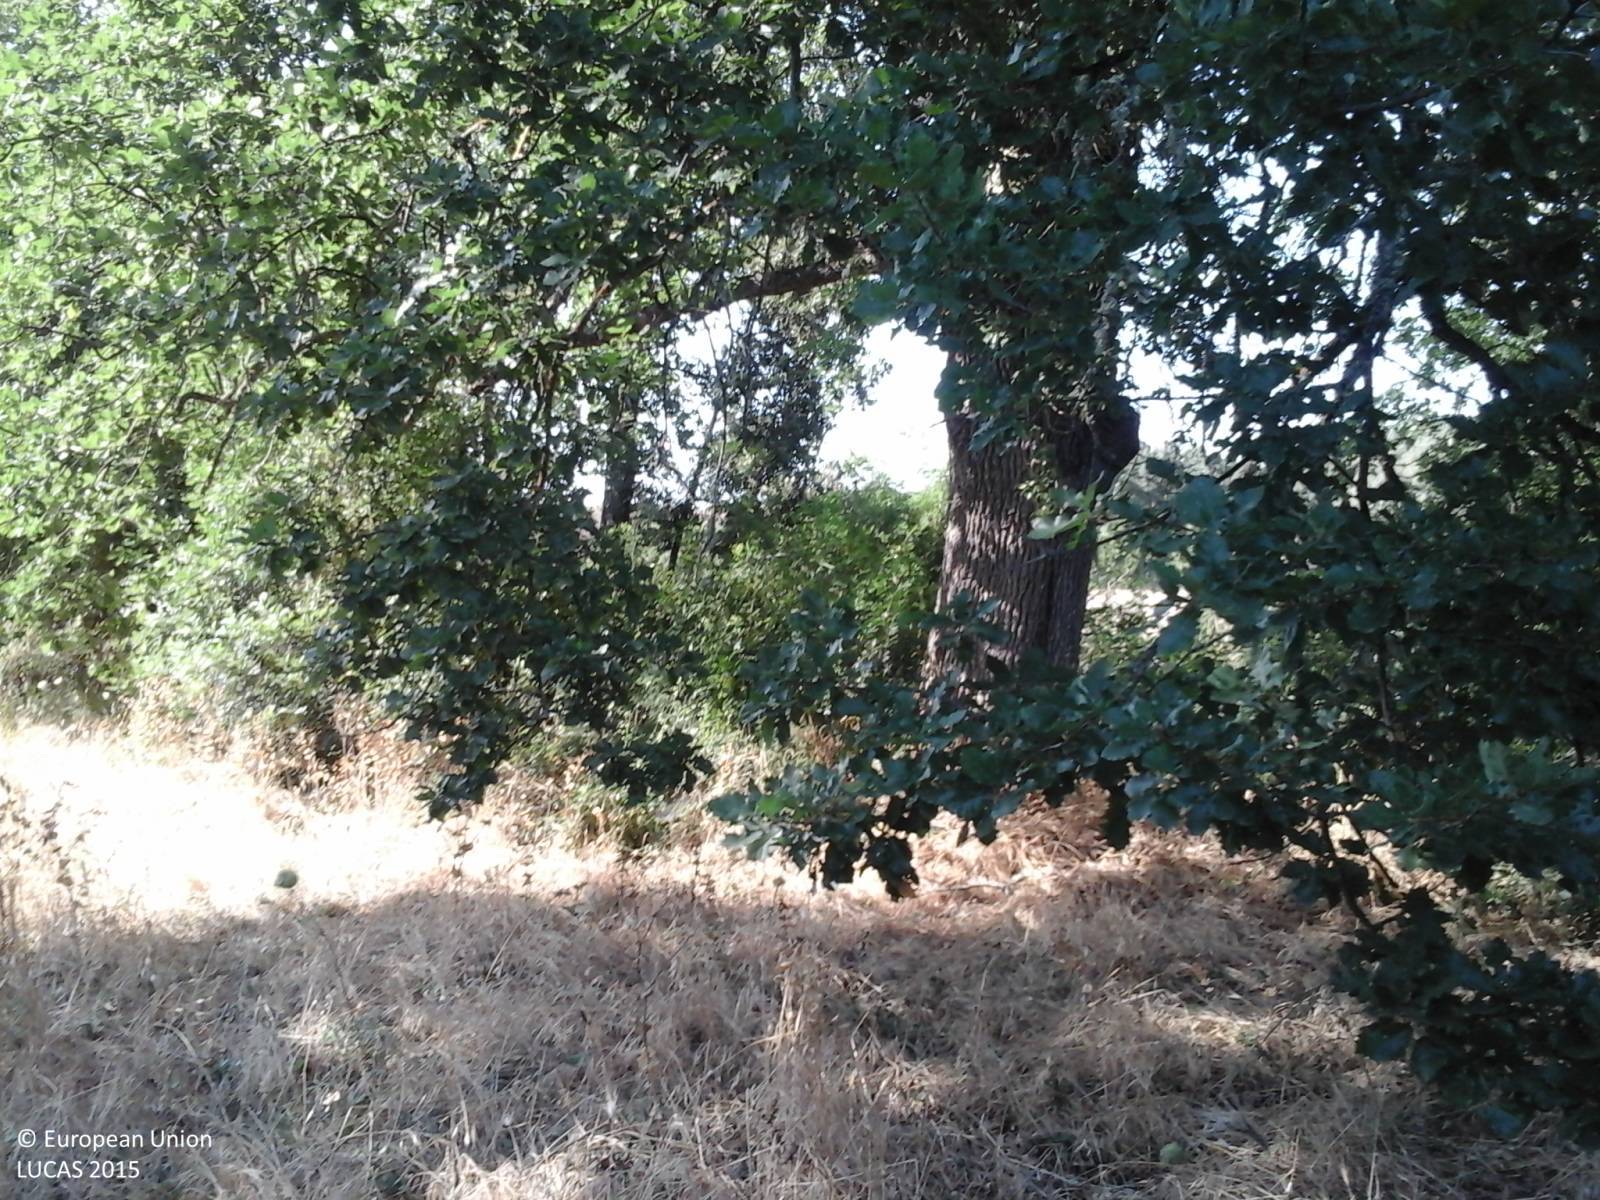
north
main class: Woodland
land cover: Broadleaved woodland
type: broadleaved evergreen forest
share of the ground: 25 - 50 %
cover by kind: broadleaved forest trees 50 %, herbaceous plants 50 %
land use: Agriculture (excluding fallow land and kitchen gardens)
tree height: < 5 m
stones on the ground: < 10 %
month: July
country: IT
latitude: 40.0254
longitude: 8.8696
